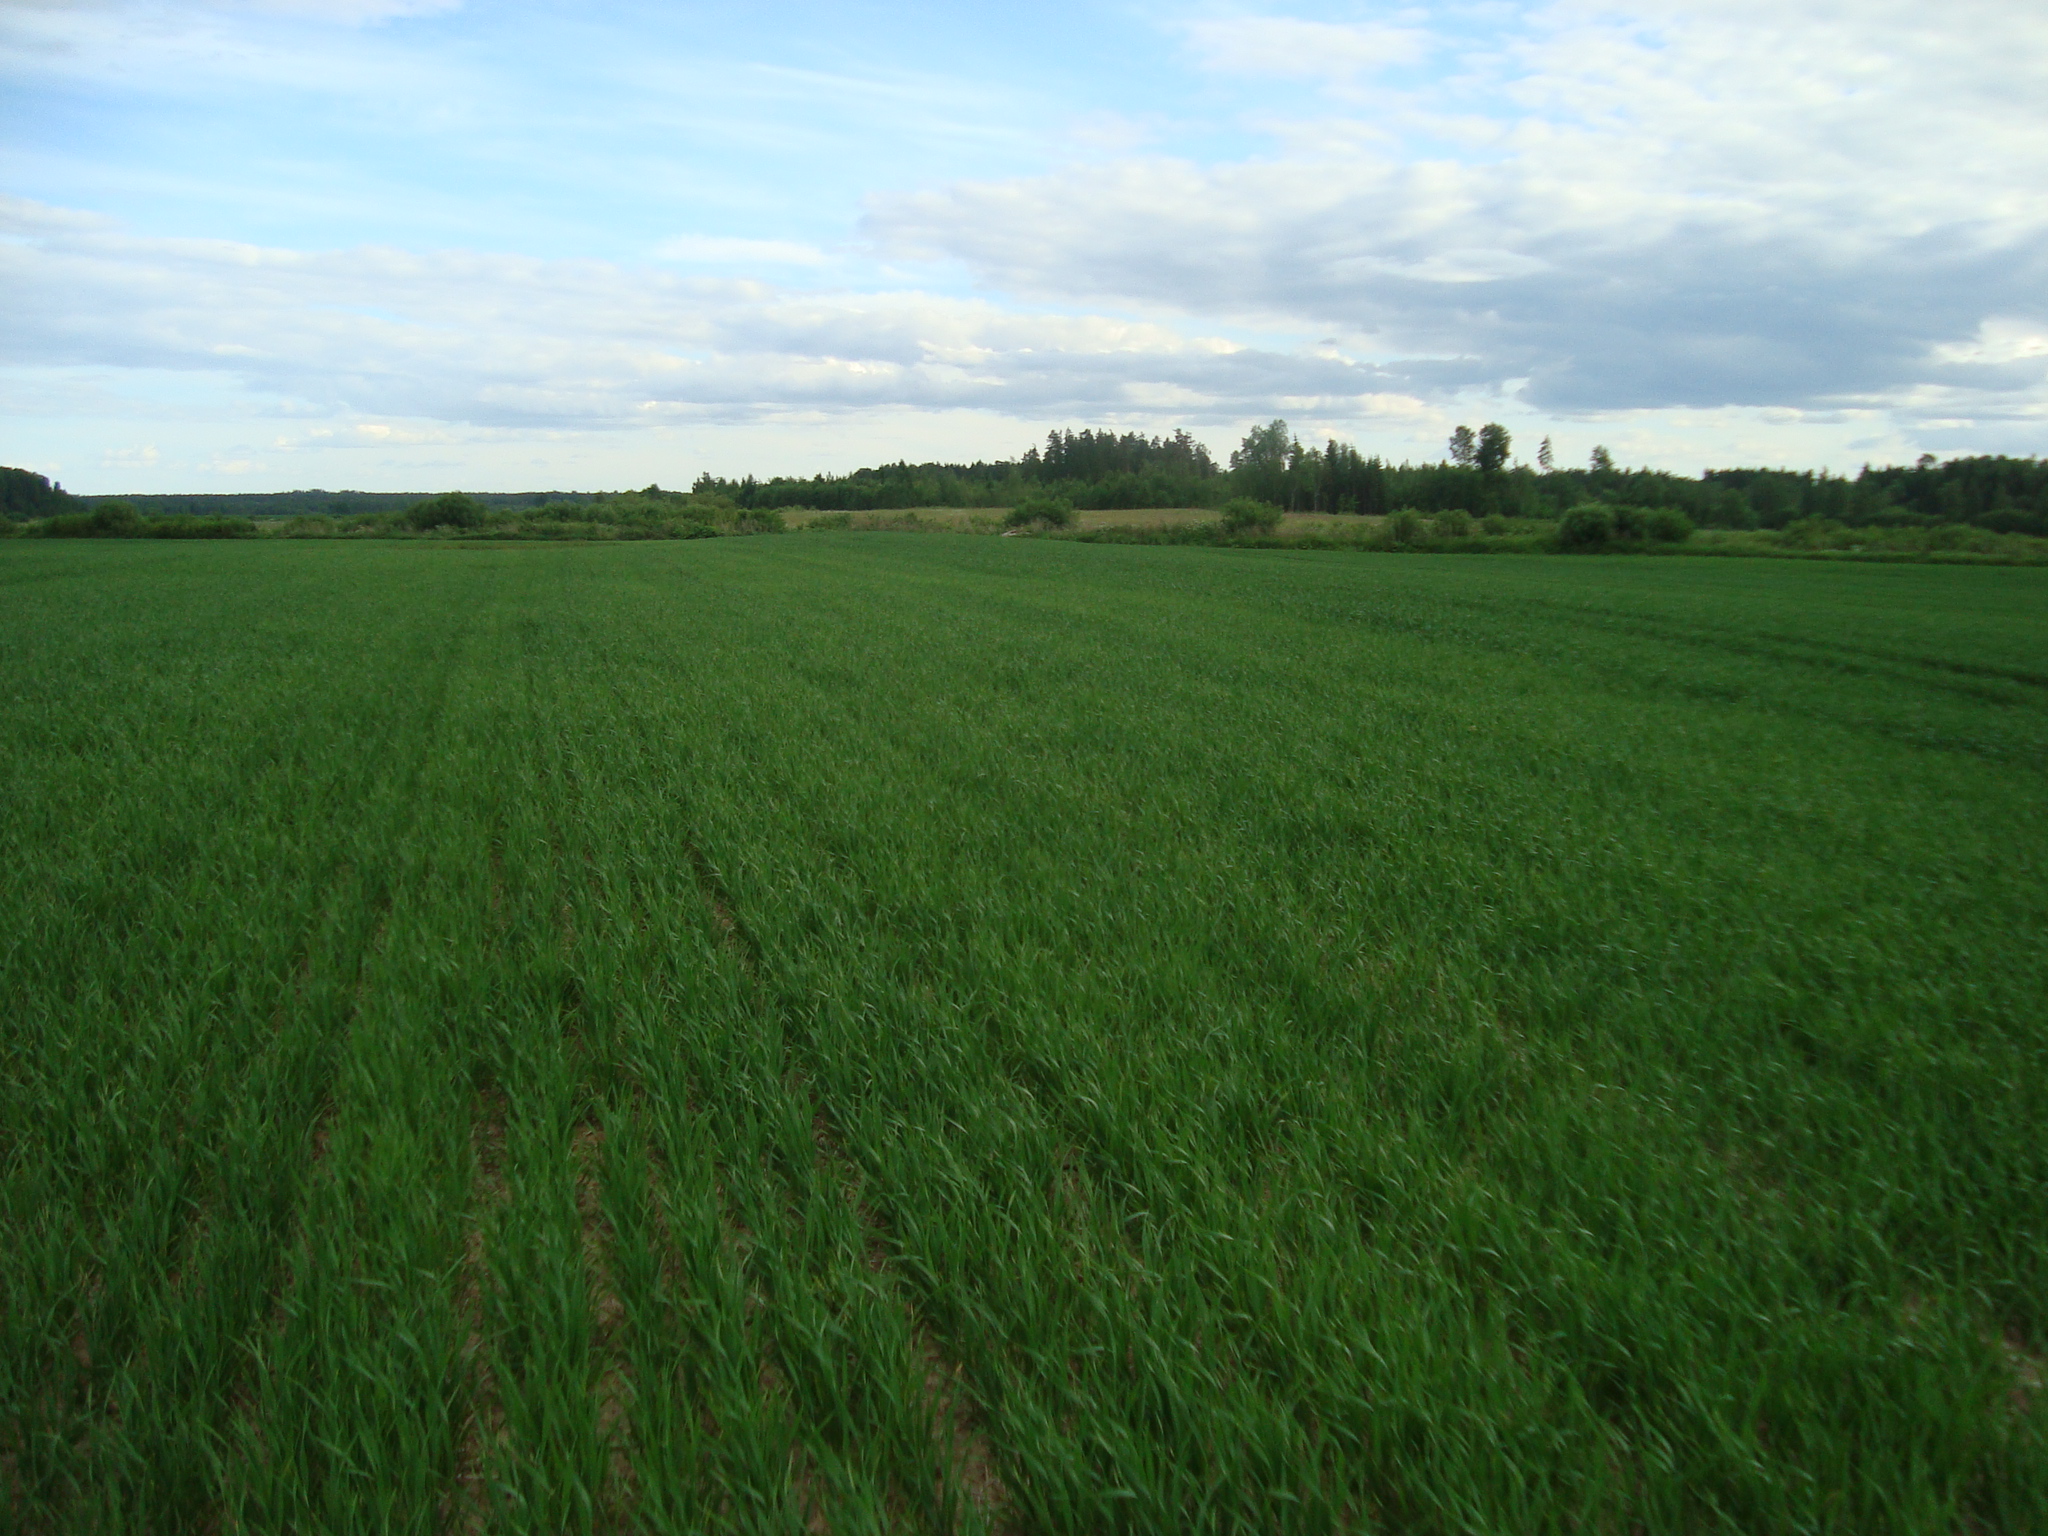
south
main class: Cropland
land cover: Barley
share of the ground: > 75 %
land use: Agriculture (excluding fallow land and kitchen gardens)
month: June
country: LV
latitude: 56.7227
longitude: 25.6639
